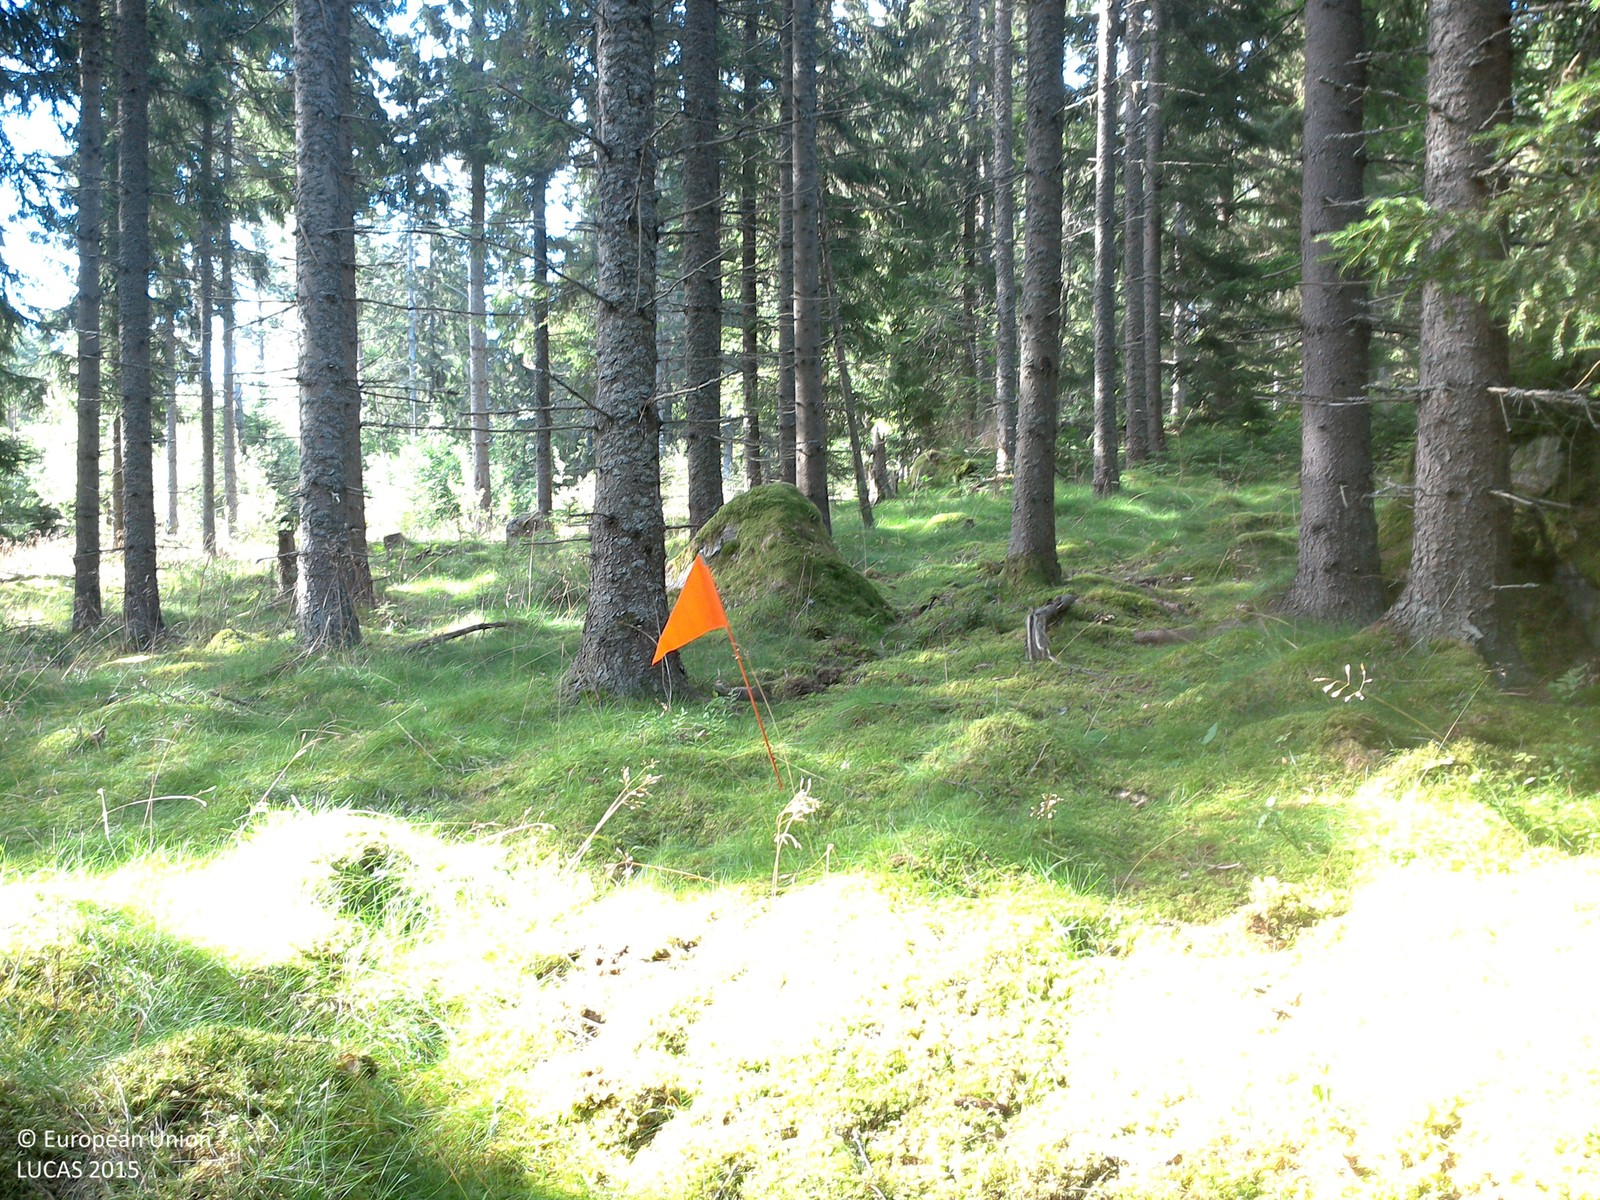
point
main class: Woodland
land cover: Spruce dominated coniferous woodland
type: boreal forest
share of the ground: 50 - 75 %
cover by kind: coniferous forest trees 55 %, lichens and mosses 45 %
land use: Forestry
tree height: > 5 m
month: August
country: SE
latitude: 58.2378
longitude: 14.9166
